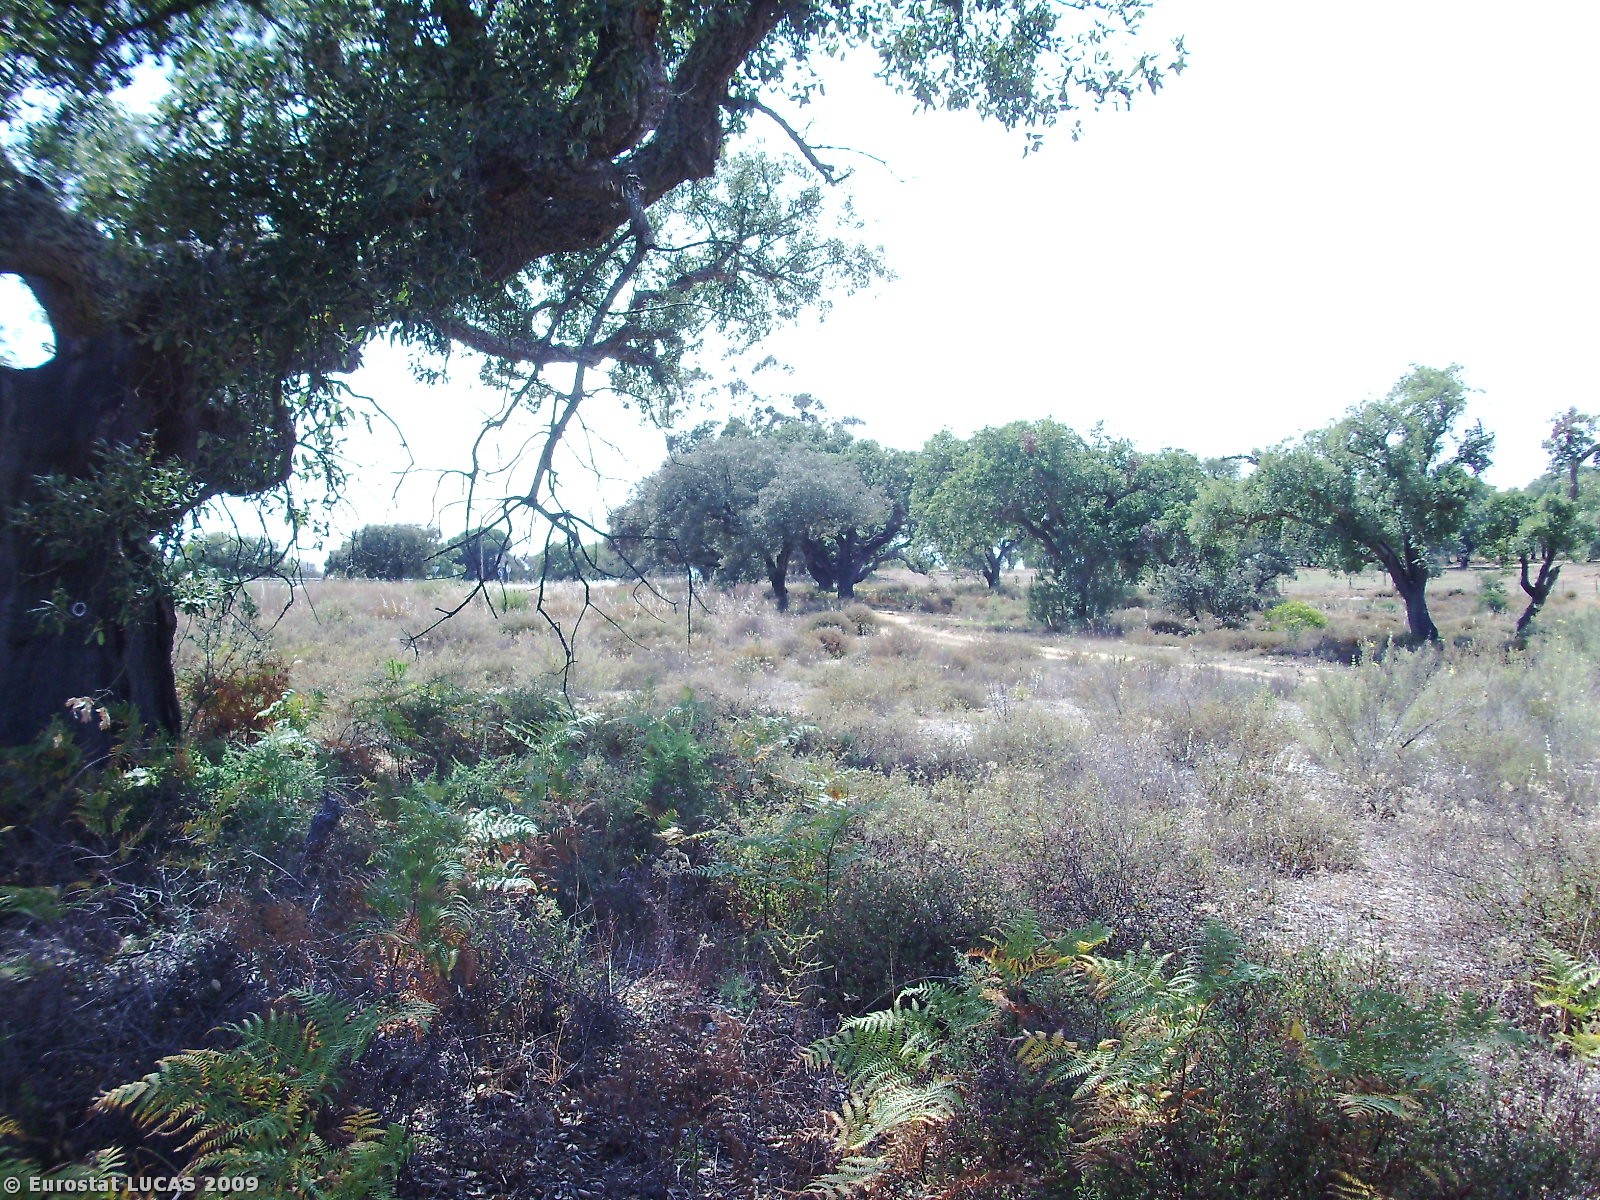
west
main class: Woodland
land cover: Broadleaved woodland
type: broadleaved evergreen forest
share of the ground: 10 - 25 %
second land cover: Shrubland with sparse tree cover
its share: 50 - 75 %
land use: Forestry
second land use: Unused
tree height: > 5 m
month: June
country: PT
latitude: 38.1397
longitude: -8.4952
